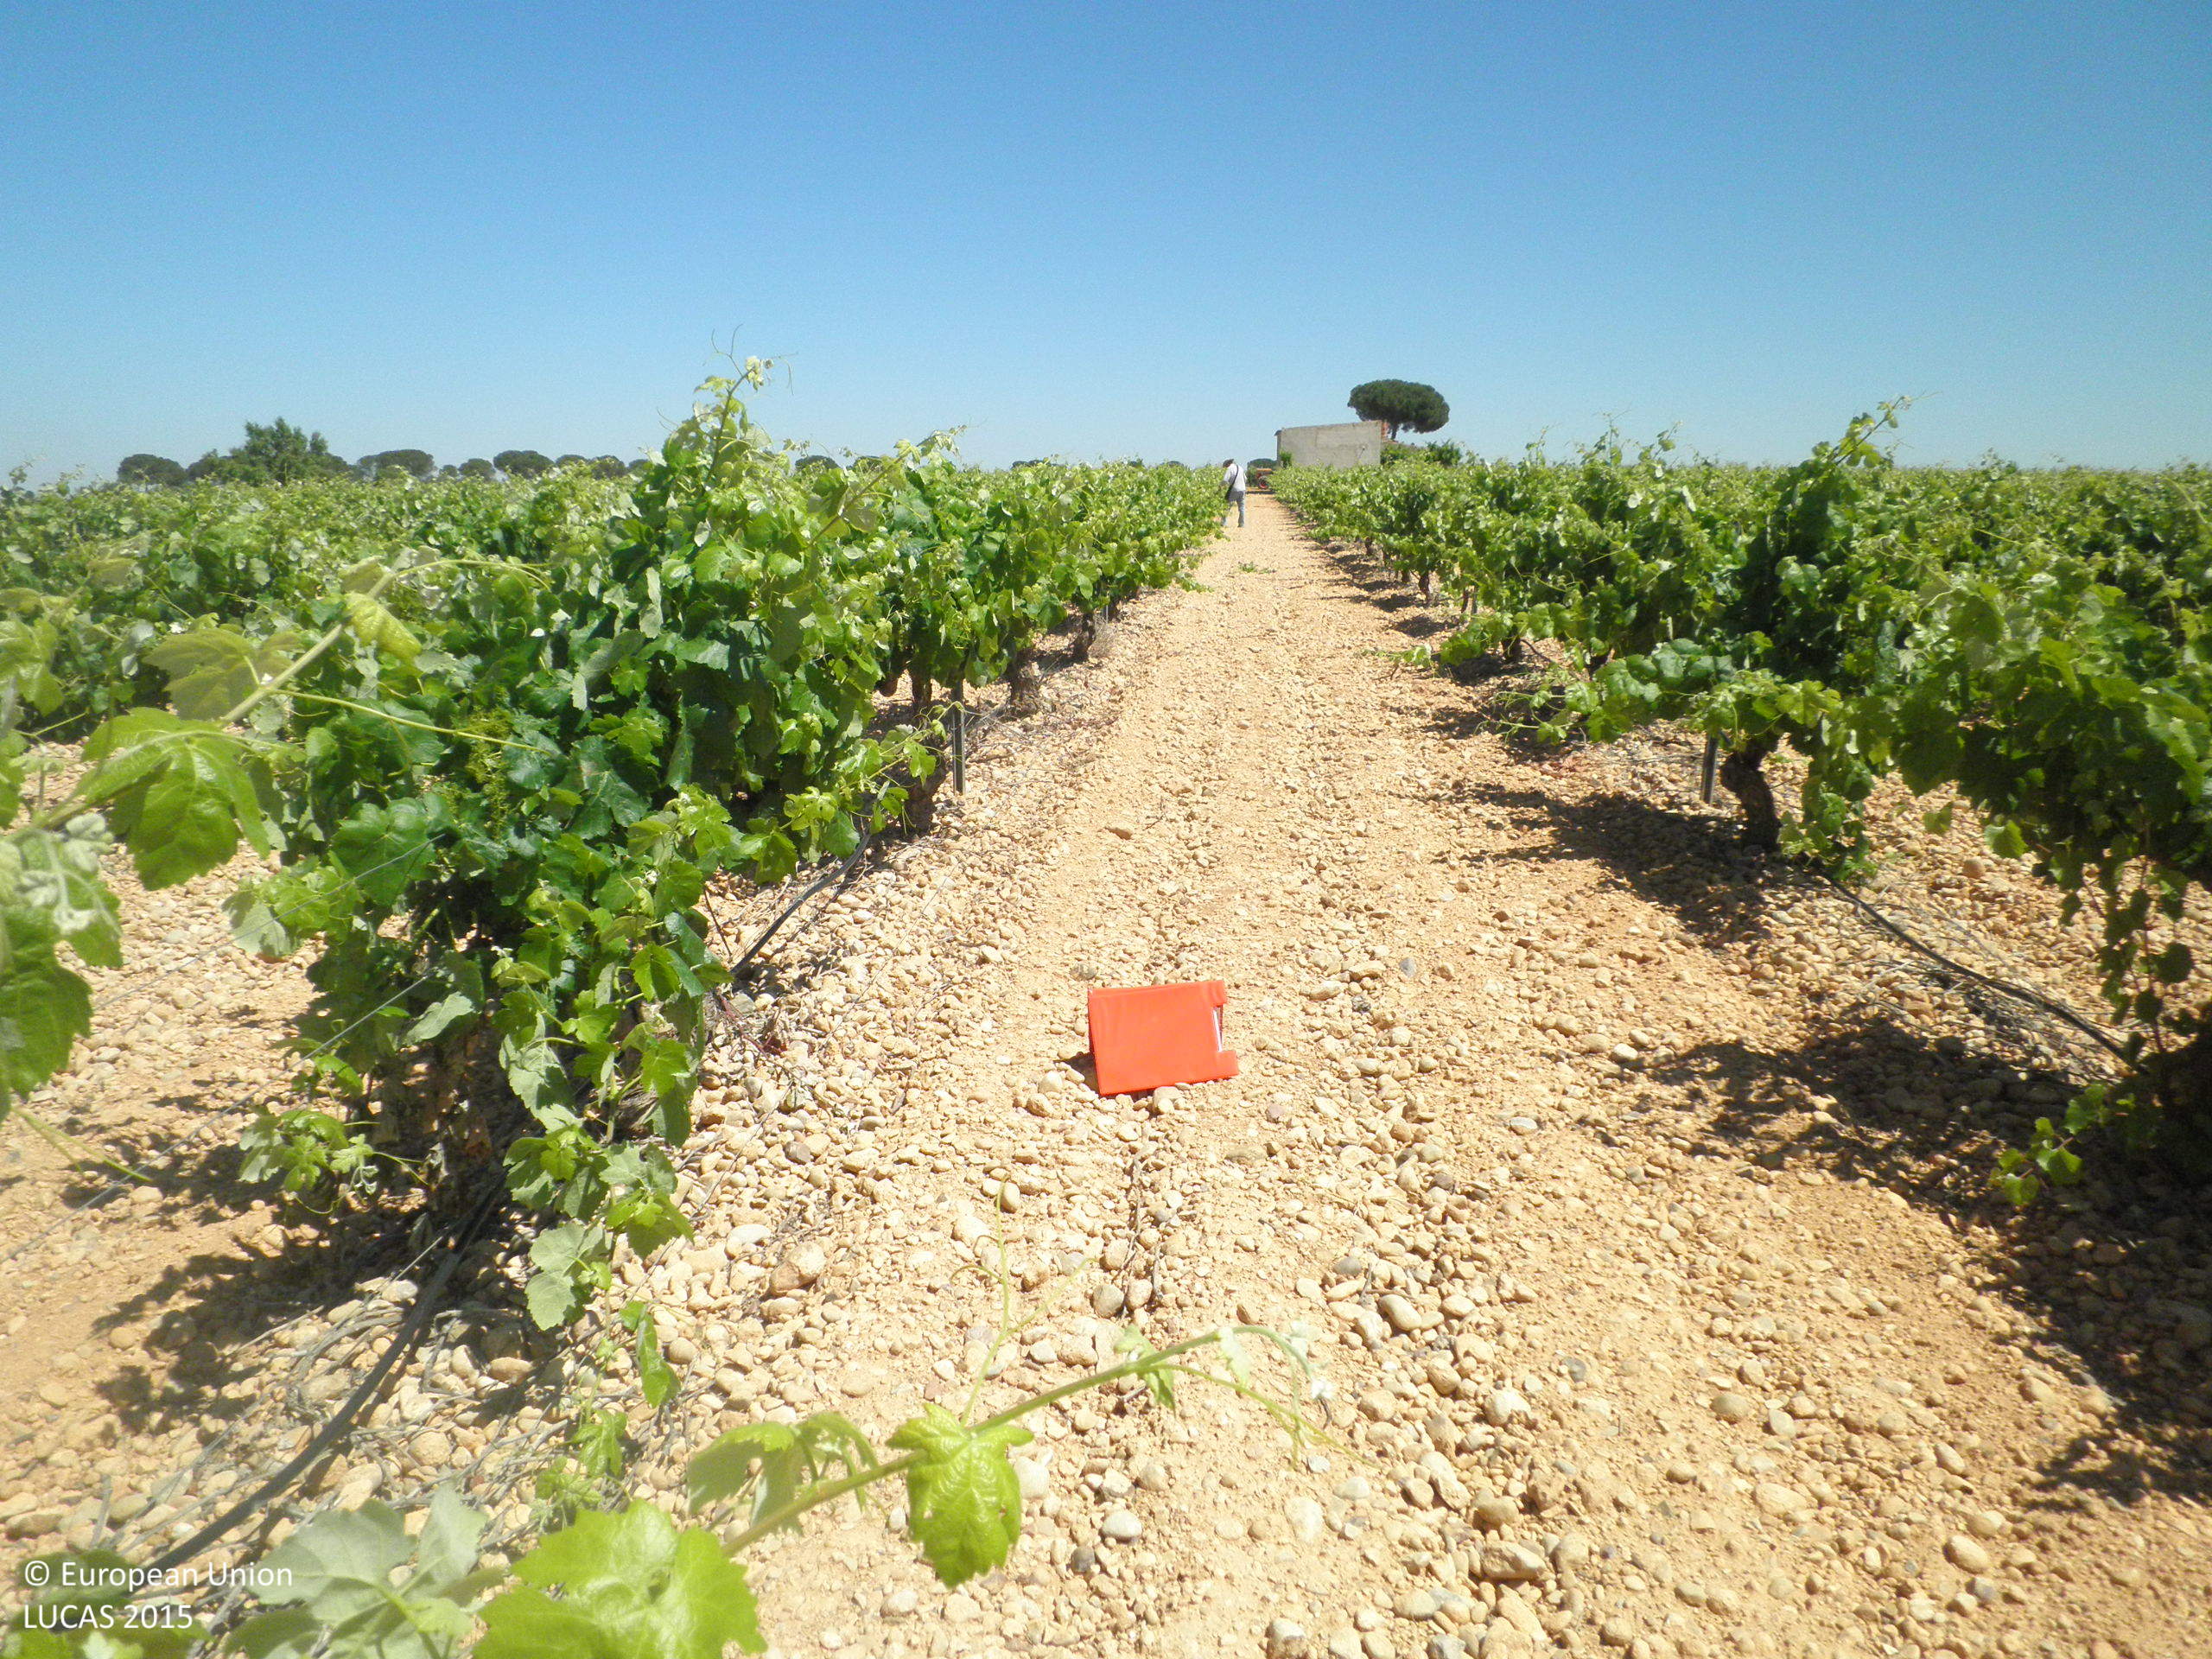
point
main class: Cropland
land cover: Vineyards
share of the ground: 10 - 25 %
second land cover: Other bare soil
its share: > 75 %
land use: Agriculture (excluding fallow land and kitchen gardens)
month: June
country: ES
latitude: 39.3497
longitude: -1.6654
